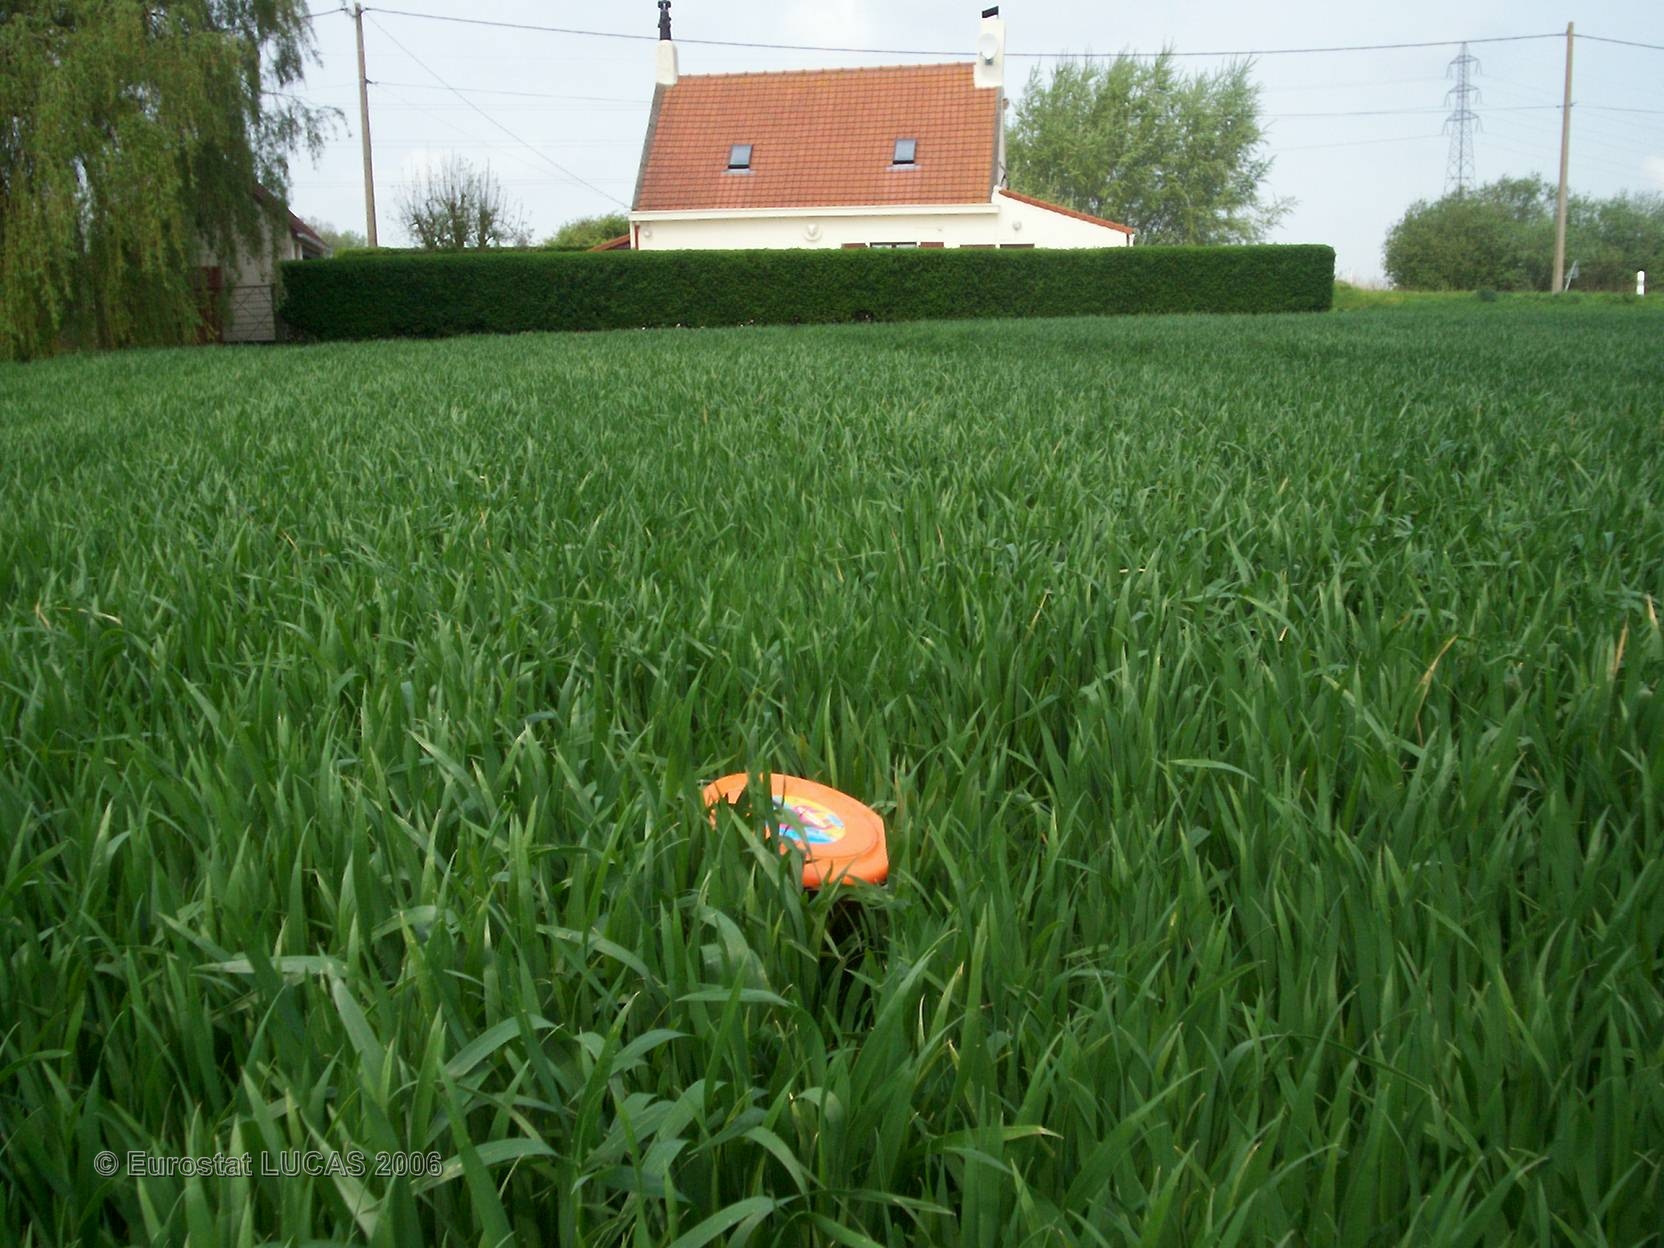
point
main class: Cropland
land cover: Common wheat
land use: Agriculture (excluding fallow land and kitchen gardens)
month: May
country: FR
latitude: 50.9701
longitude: 2.2818
